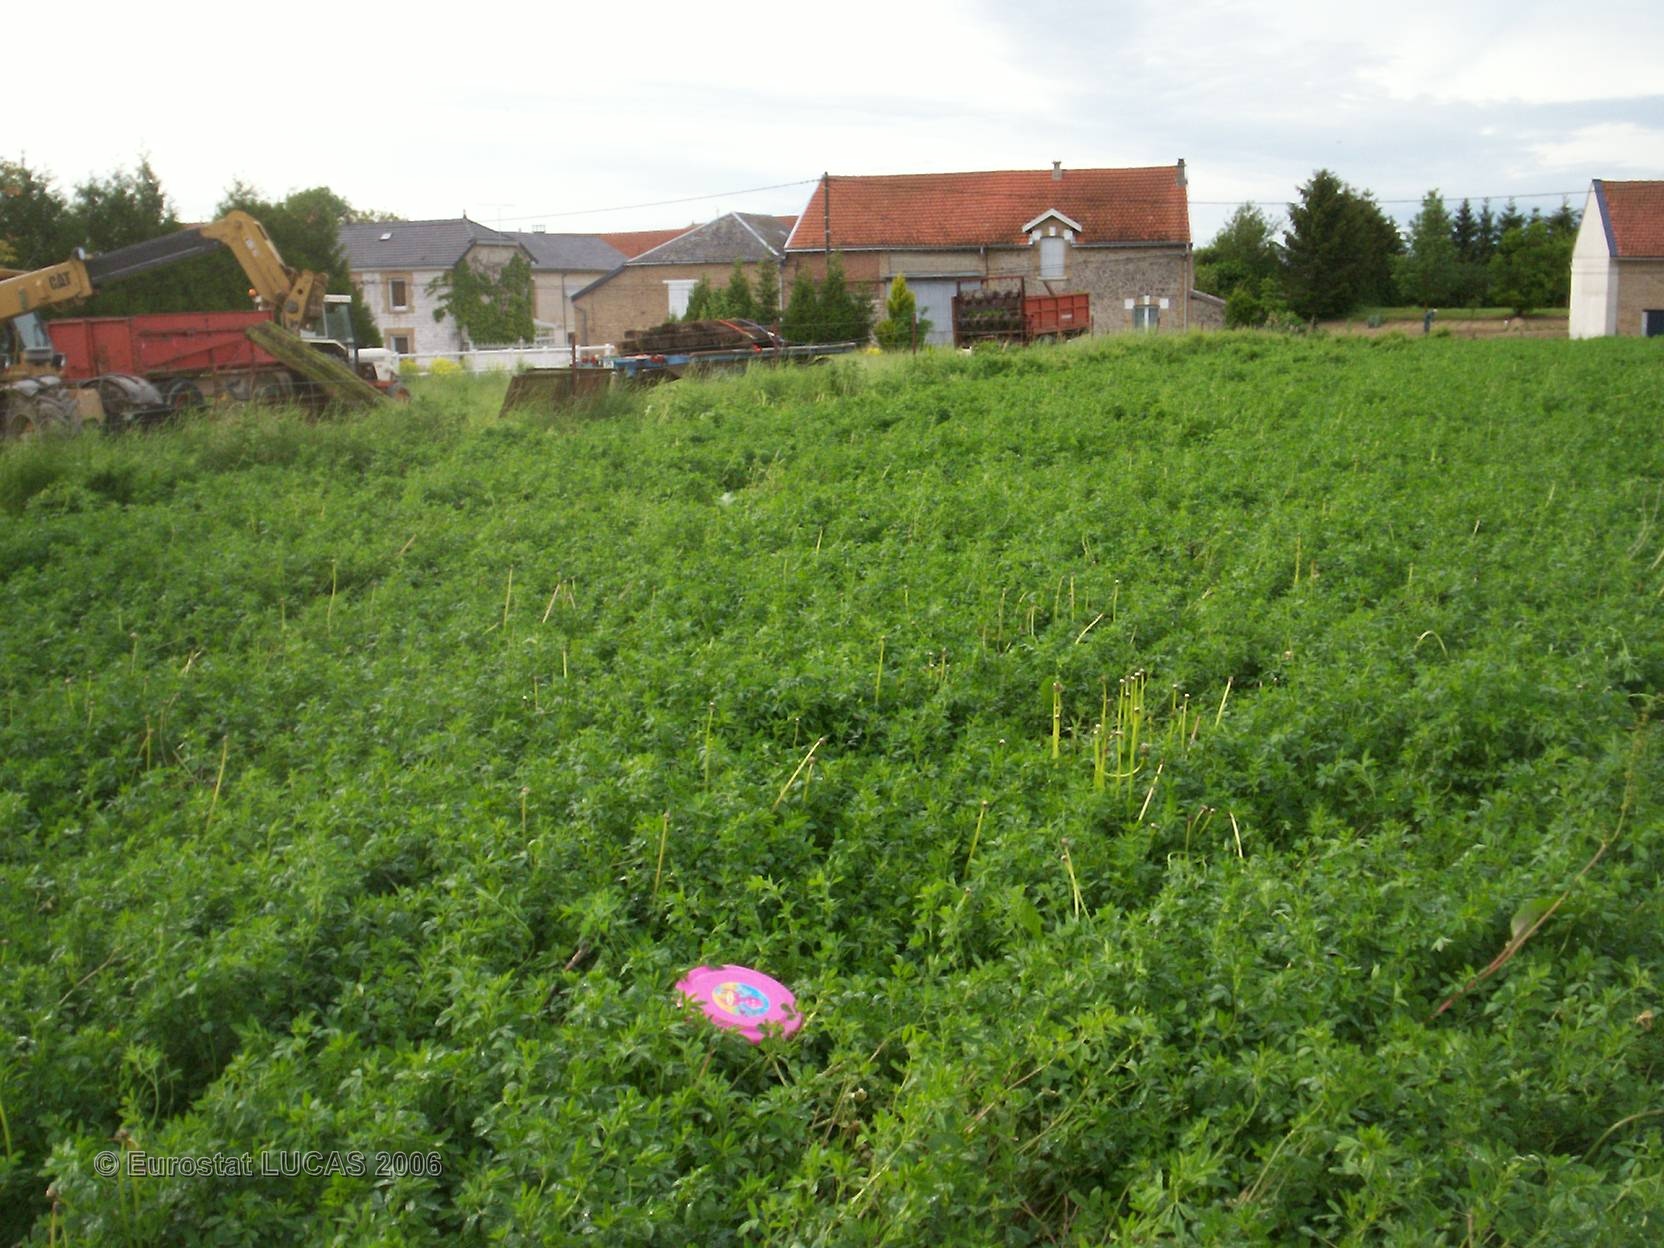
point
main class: Cropland
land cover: Lucerne
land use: Agriculture (excluding fallow land and kitchen gardens)
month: May
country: FR
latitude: 49.4495
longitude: 4.3542
